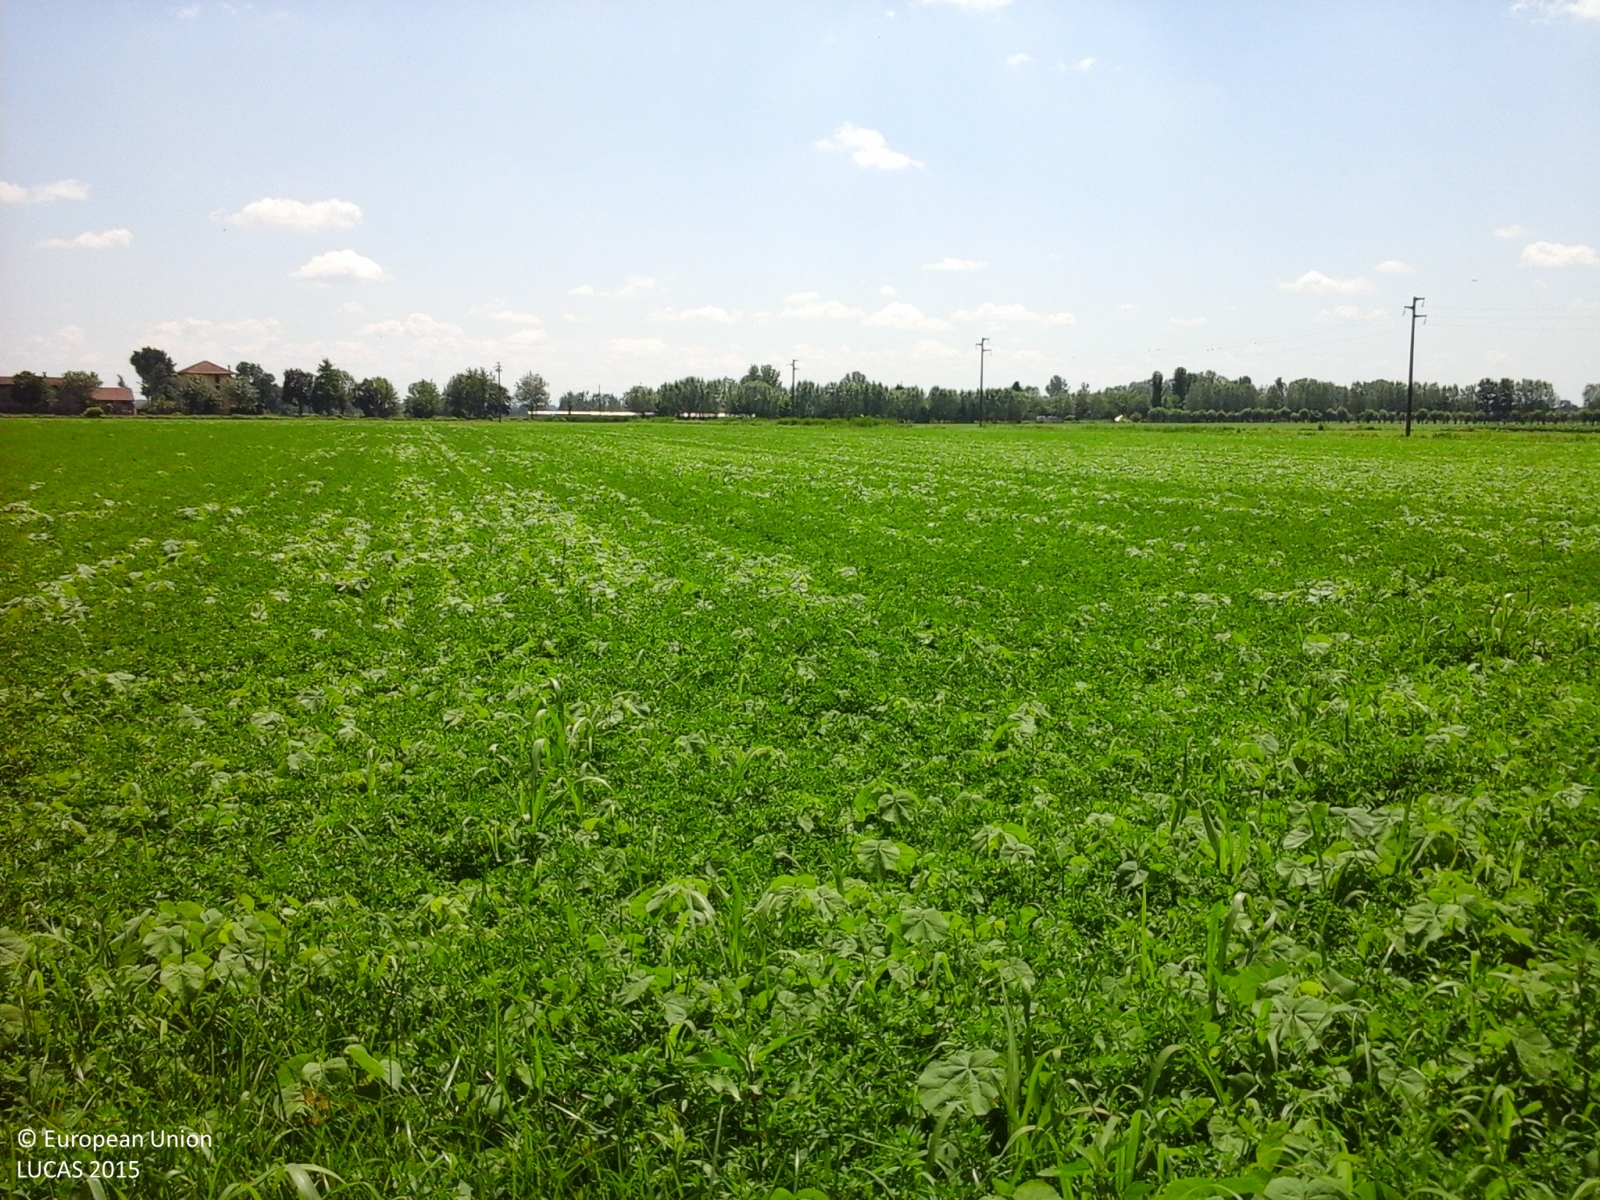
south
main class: Cropland
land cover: Lucerne
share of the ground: > 75 %
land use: Agriculture (excluding fallow land and kitchen gardens)
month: May
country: IT
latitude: 45.4318
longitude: 9.6555
